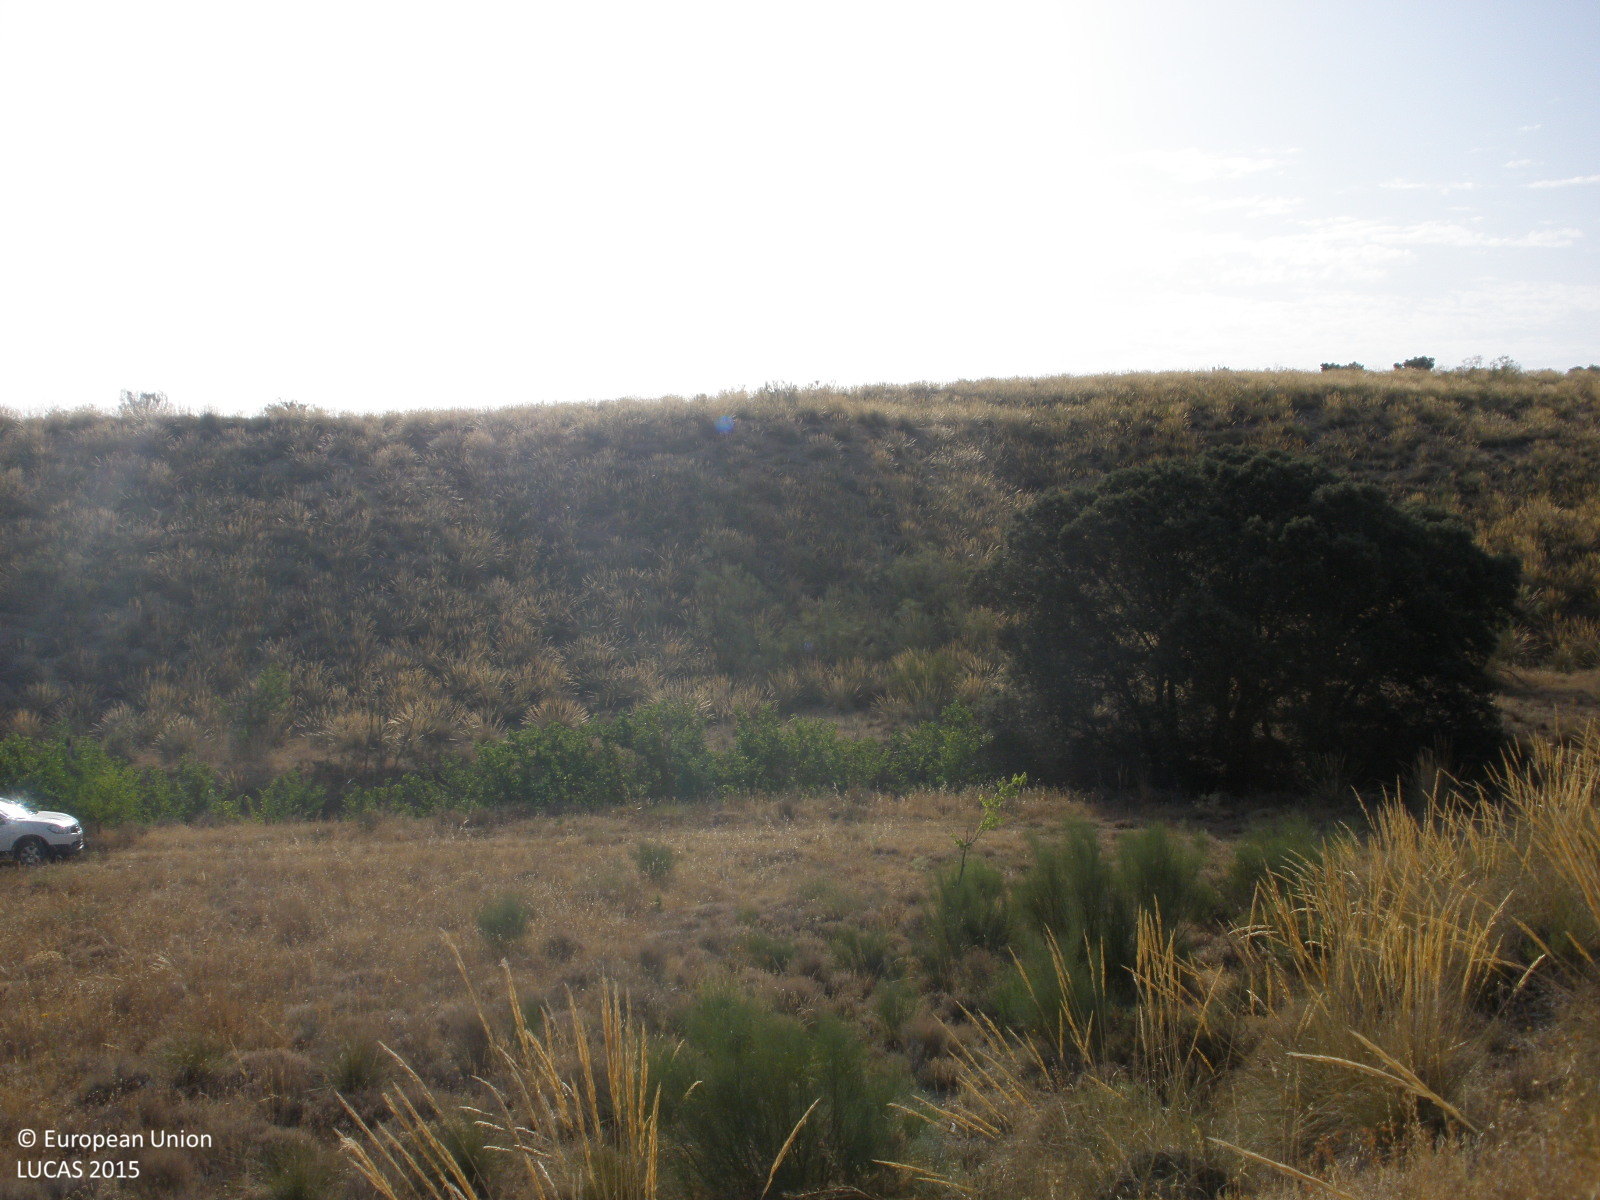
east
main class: Shrubland
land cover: Shrubland without tree cover
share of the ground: 25 - 50 %
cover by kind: herbaceous plants 60 %, shrubs 30 %, consolidated bare surface 10 %
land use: Semi-natural and natural areas not in use
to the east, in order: Shrubland without tree cover; Grassland without tree/shrub cover; Tracks; Abandoned hedges; Rivers and streams; Shrubland without tree cover; Tracks; Shruby margins; Olive groves; Grass margins; Tracks
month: July
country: ES
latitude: 40.0360
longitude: -3.4243
